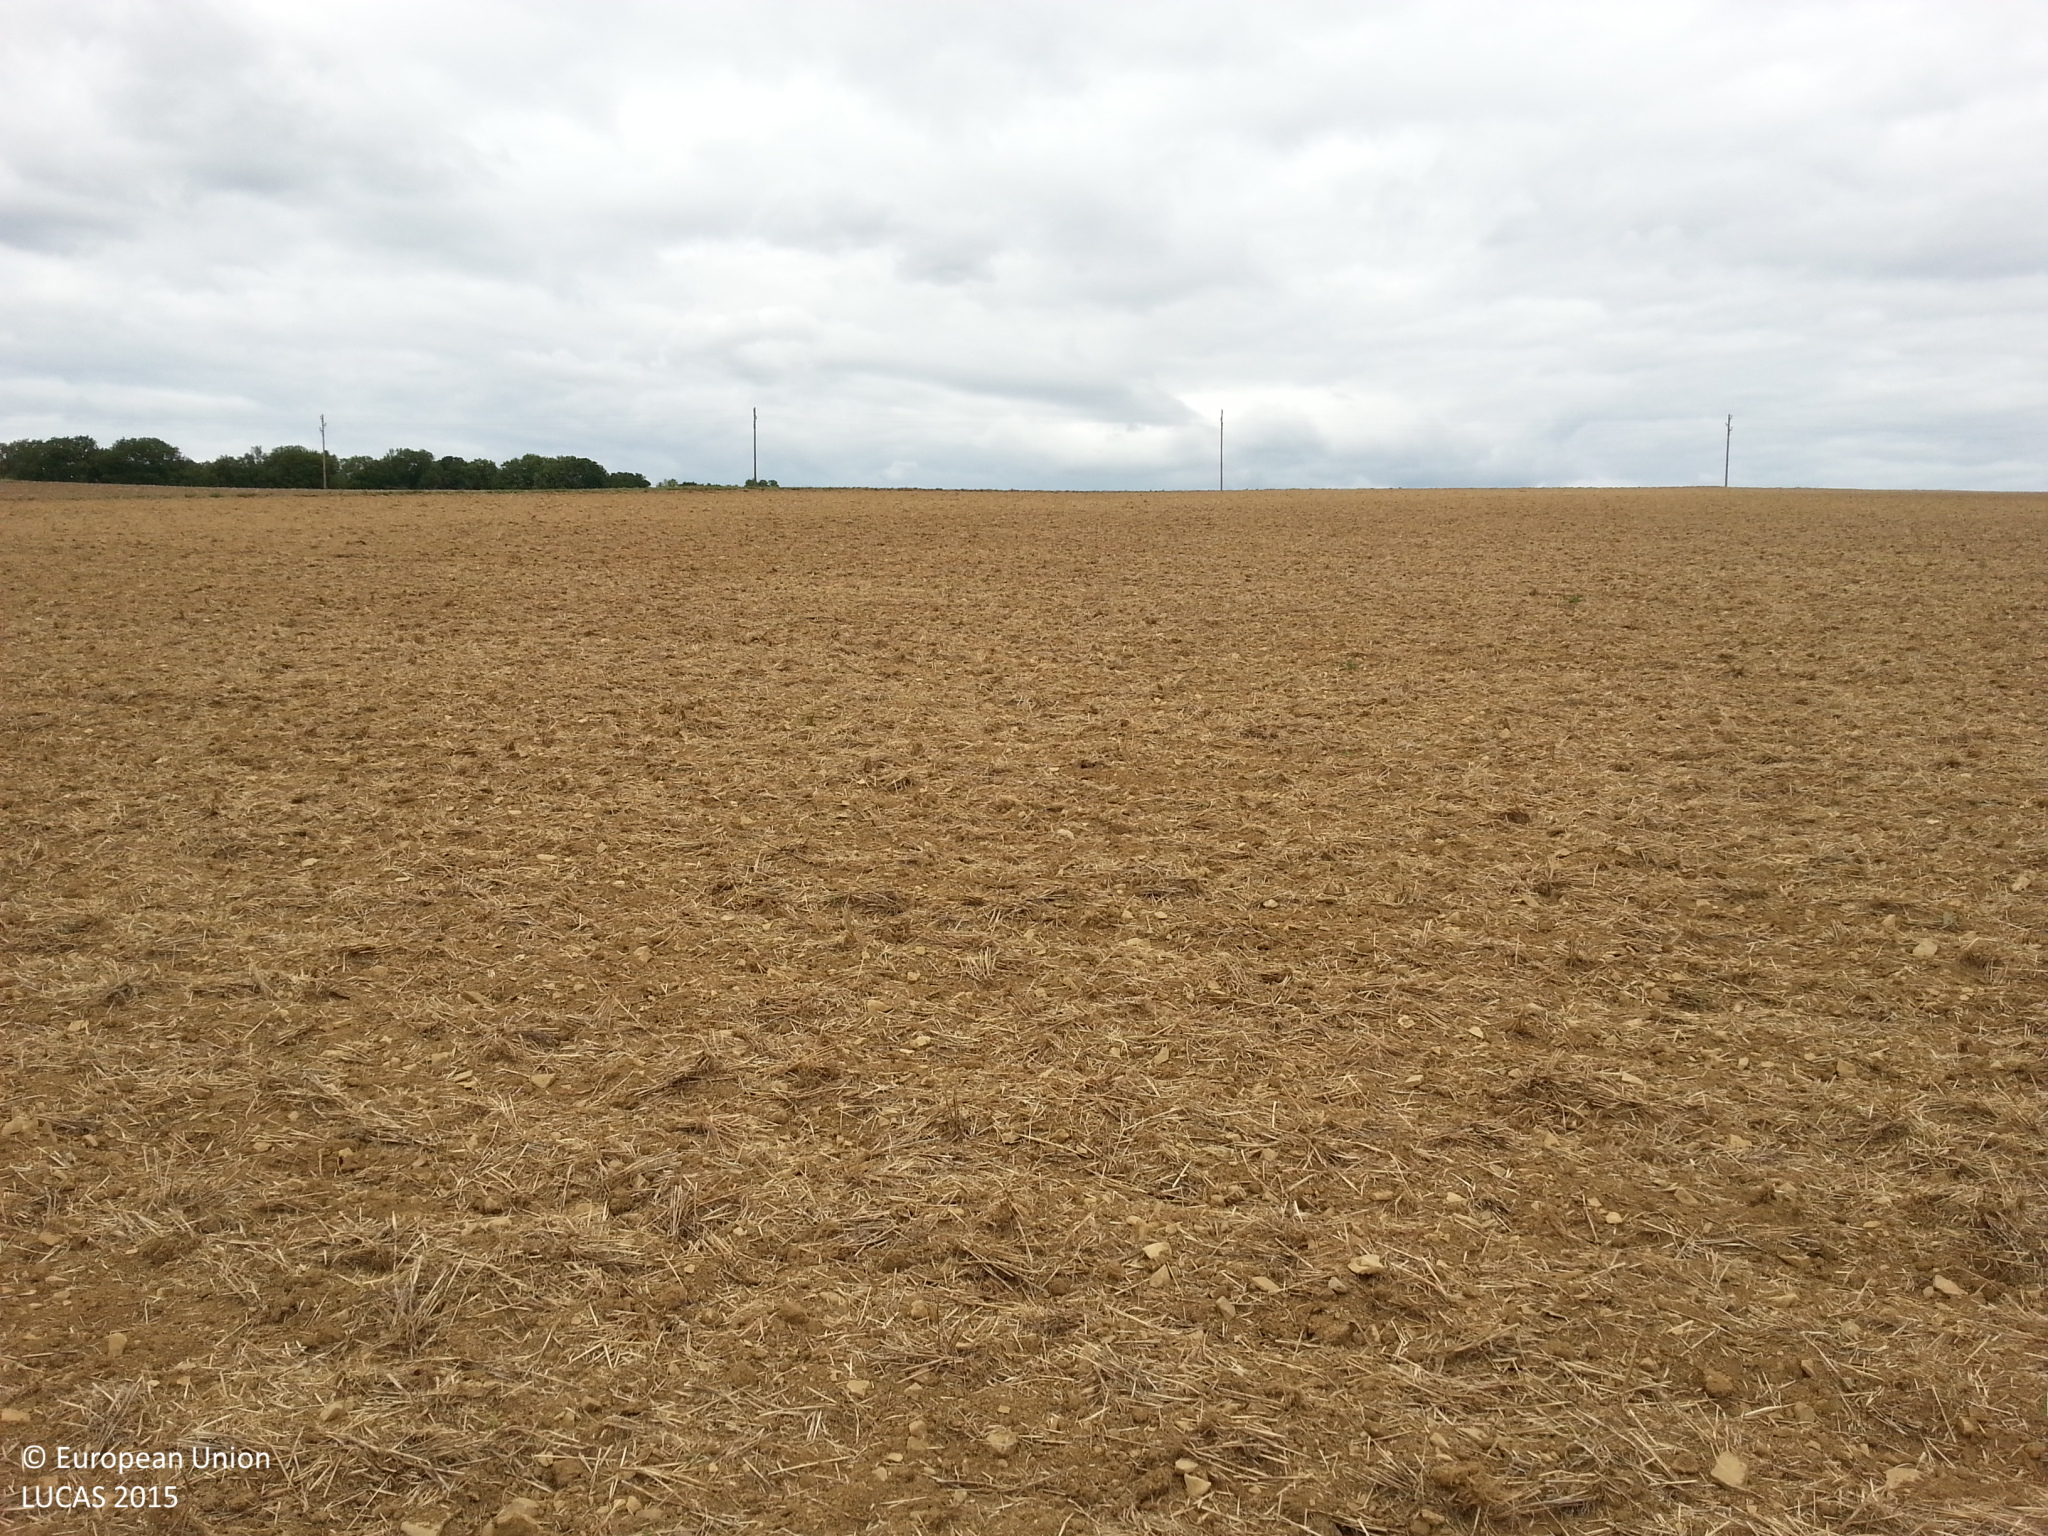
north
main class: Cropland
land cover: Common wheat
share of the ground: < 10 %
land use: Agriculture (excluding fallow land and kitchen gardens)
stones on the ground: 10 - 25 %
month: September
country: DE
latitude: 49.6259
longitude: 9.5710
